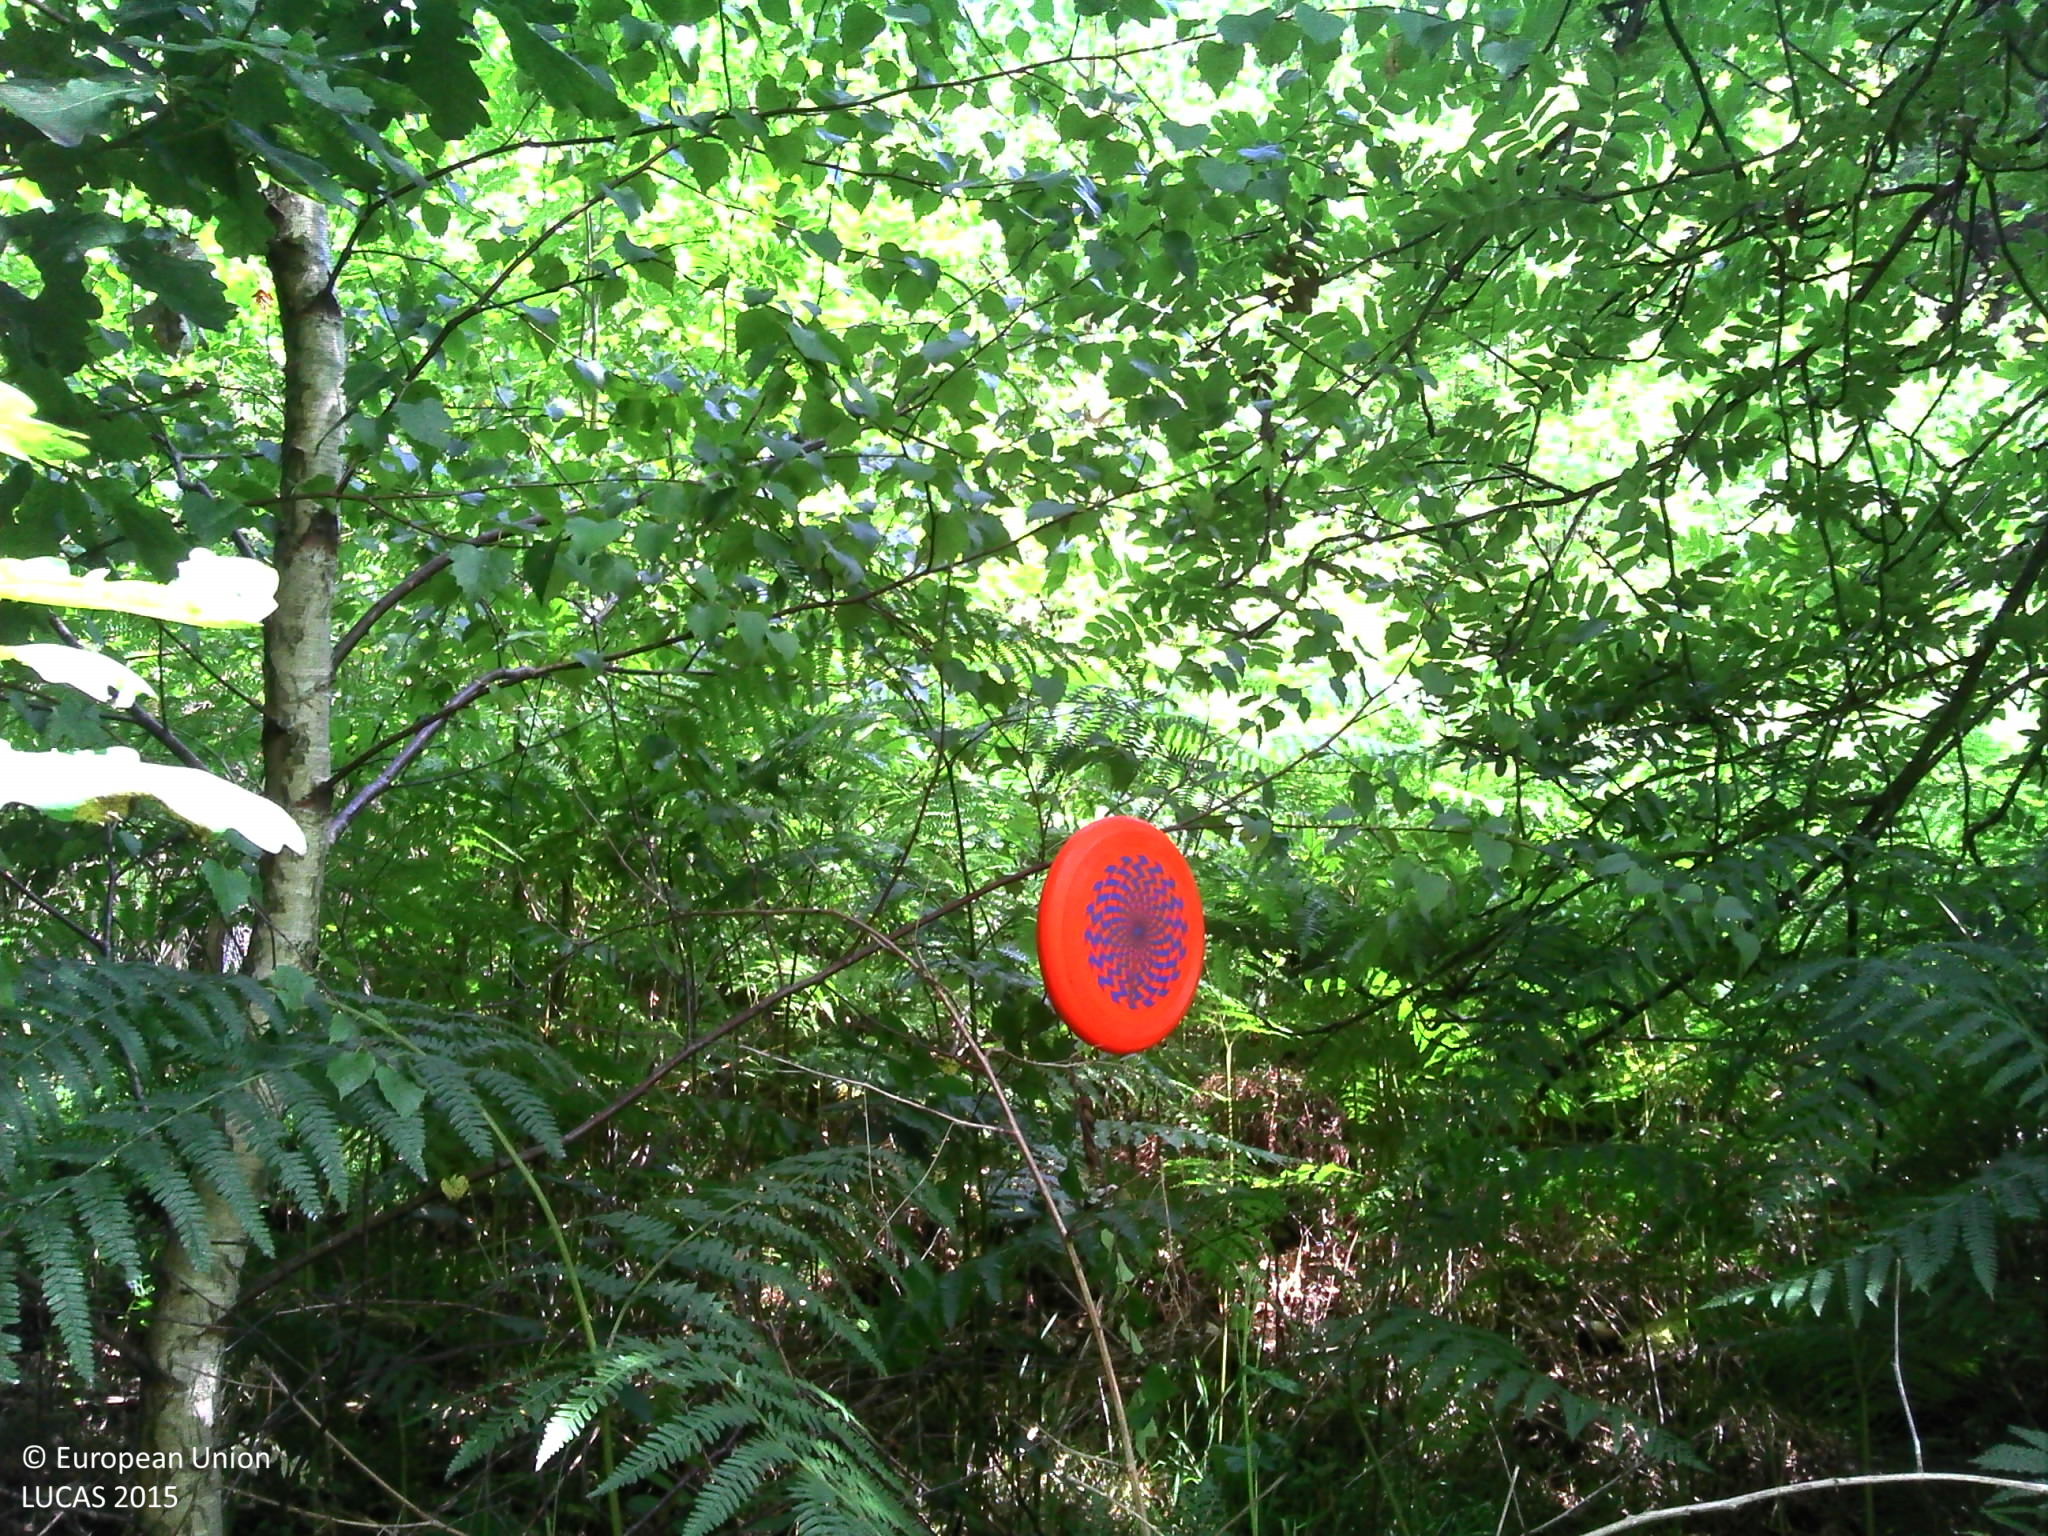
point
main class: Woodland
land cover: Broadleaved woodland
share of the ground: 50 - 75 %
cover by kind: broadleaved forest trees 60 %, herbaceous plants 30 %, shrubs 10 %
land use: Forestry
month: July
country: BE
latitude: 49.9619
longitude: 5.7750
